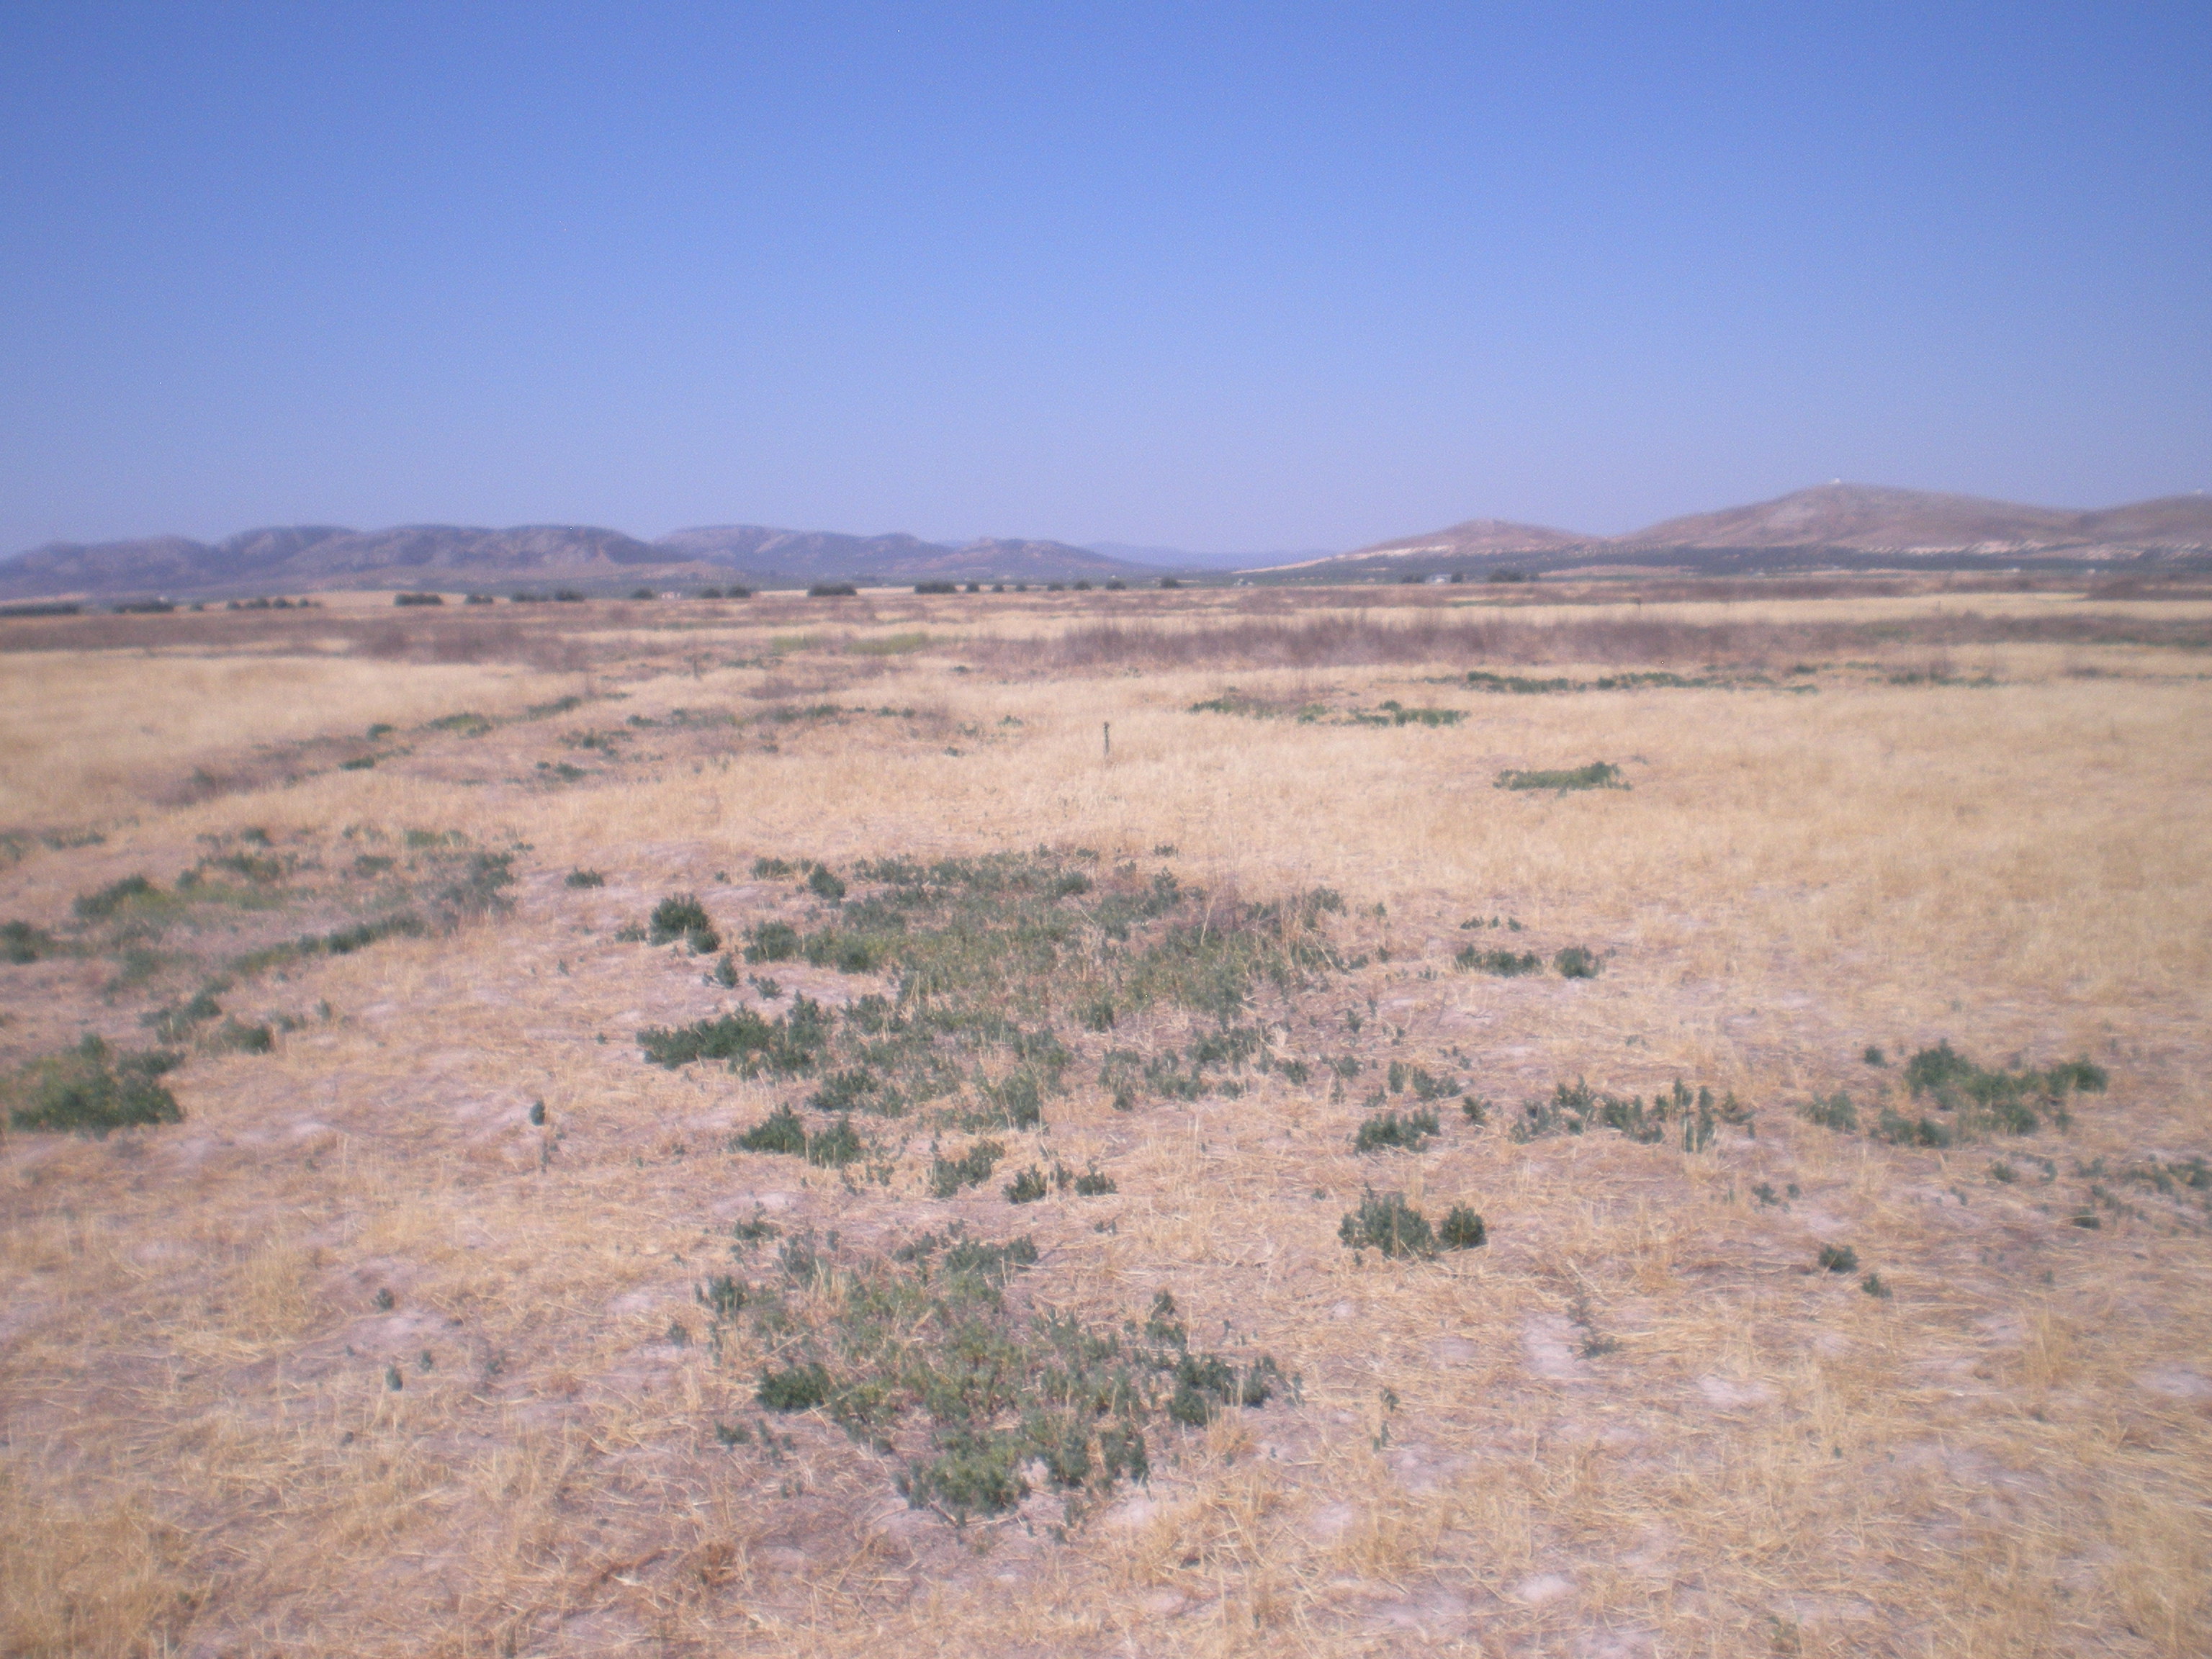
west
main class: Grassland
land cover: Grassland without tree/shrub cover
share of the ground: 10 - 25 %
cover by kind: unconsolidated bare surface 85 %, herbaceous plants 15 %
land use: Agriculture (excluding fallow land and kitchen gardens)
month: July
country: ES
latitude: 39.3387
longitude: -3.3027
